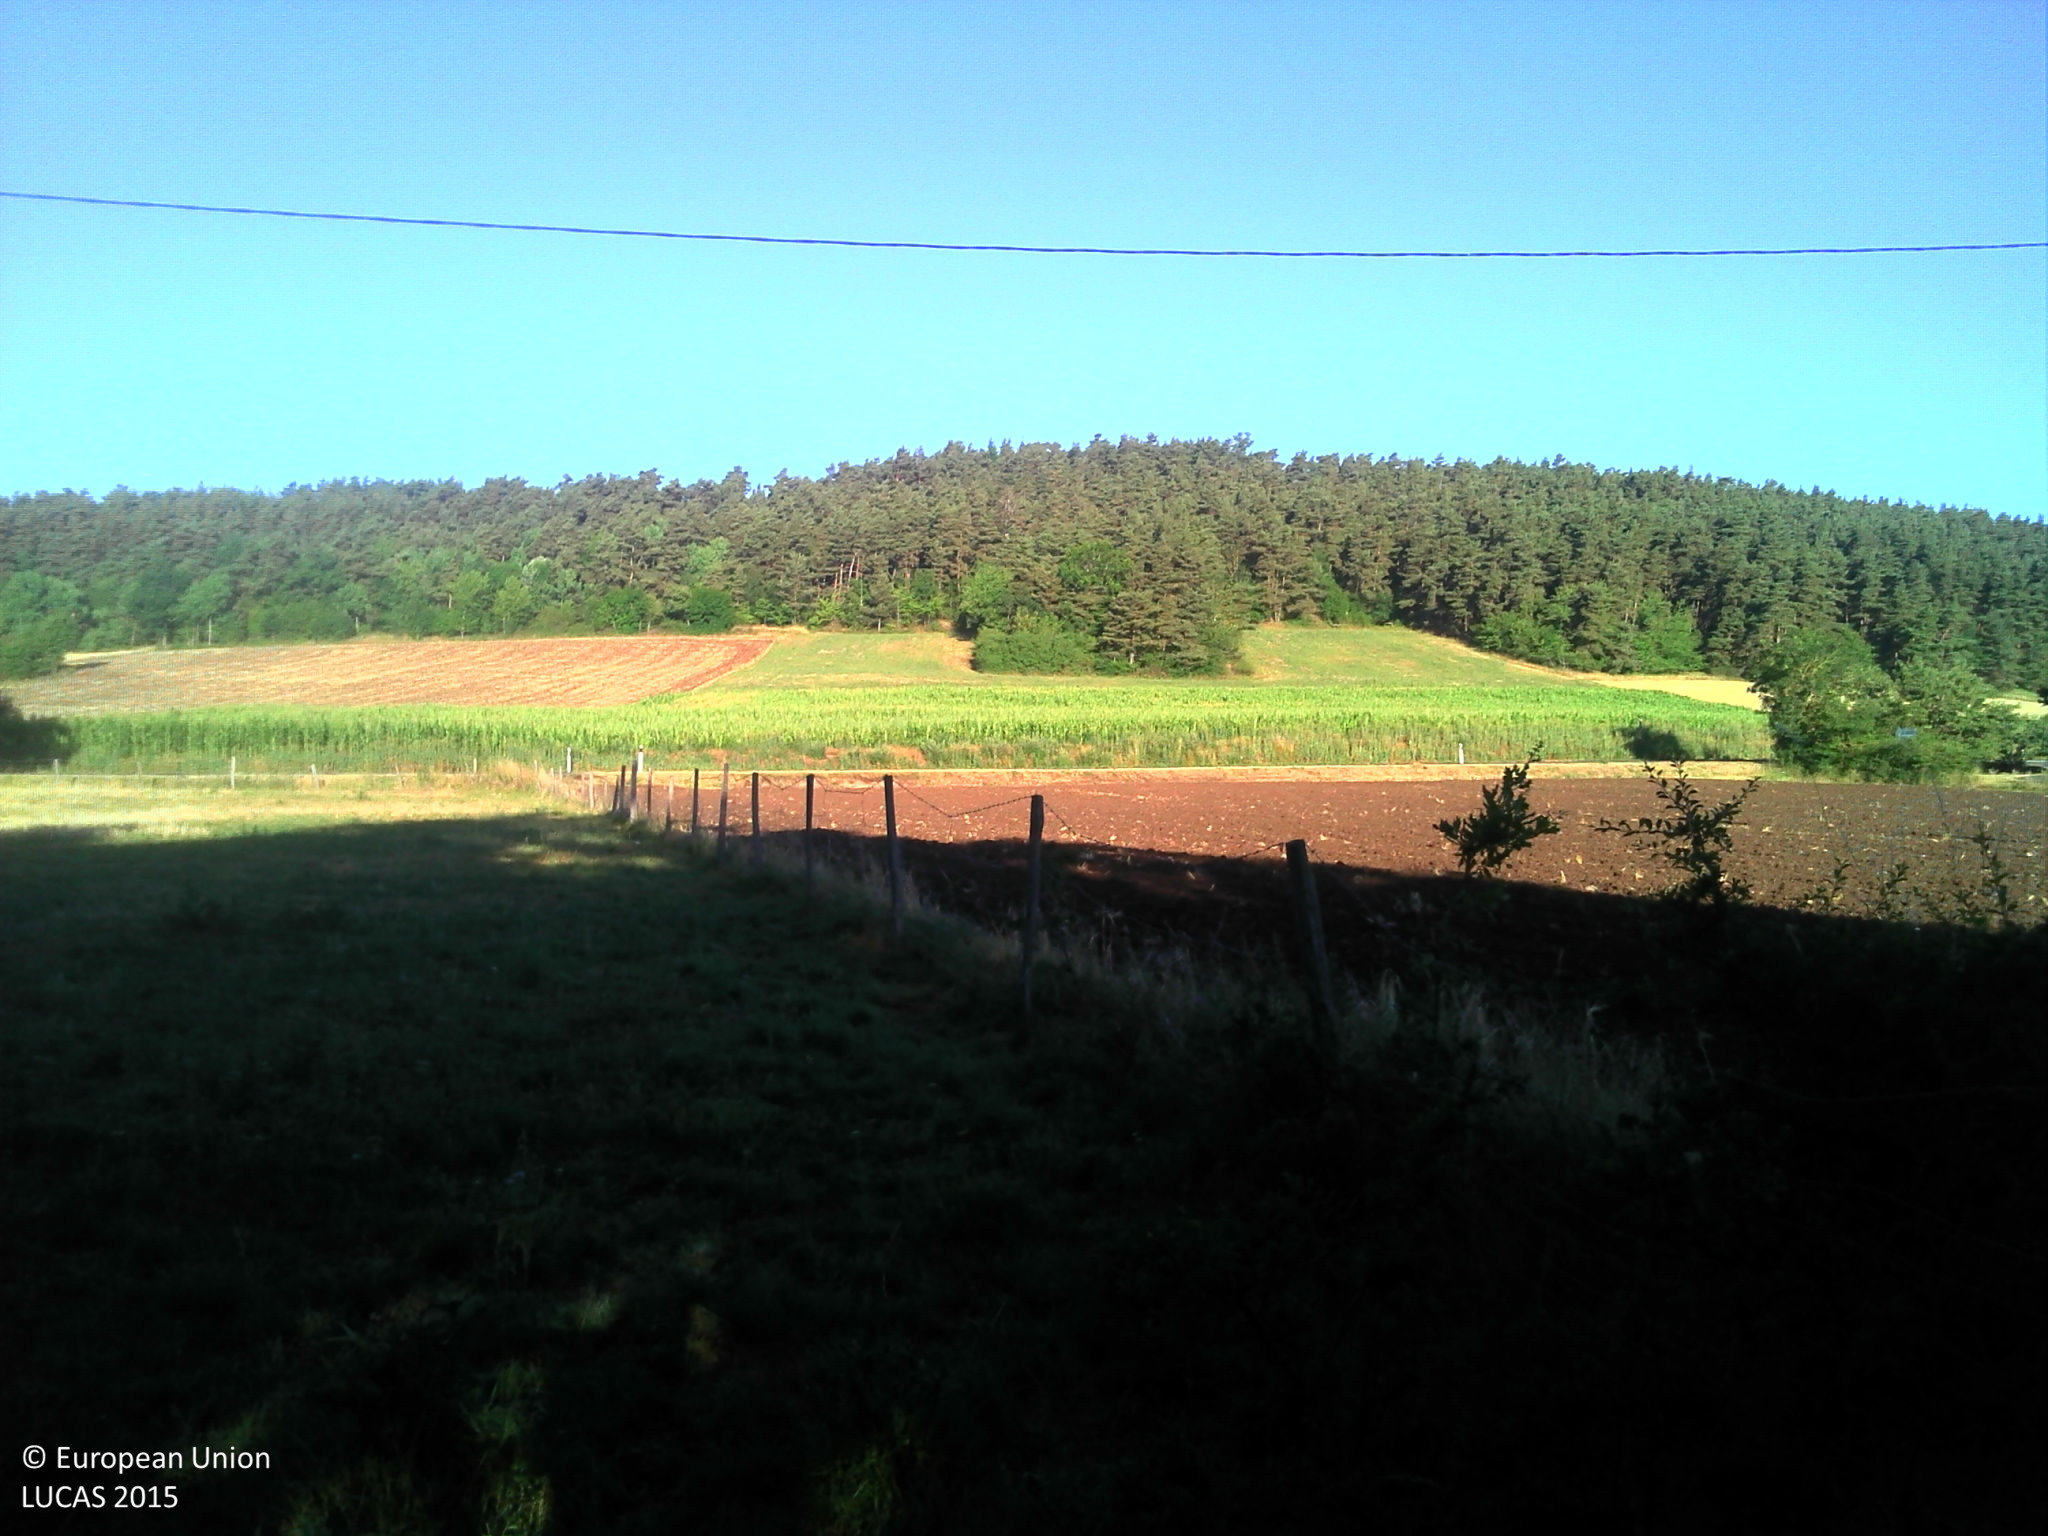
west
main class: Woodland
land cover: Pine dominated mixed woodland
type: acidophilous oak and oak-birch forest
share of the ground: > 75 %
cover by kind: coniferous forest trees 60 %, broadleaved forest trees 20 %, herbaceous plants 20 %
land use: Forestry
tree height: > 5 m
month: July
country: FR
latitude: 45.0882
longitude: 3.8164
